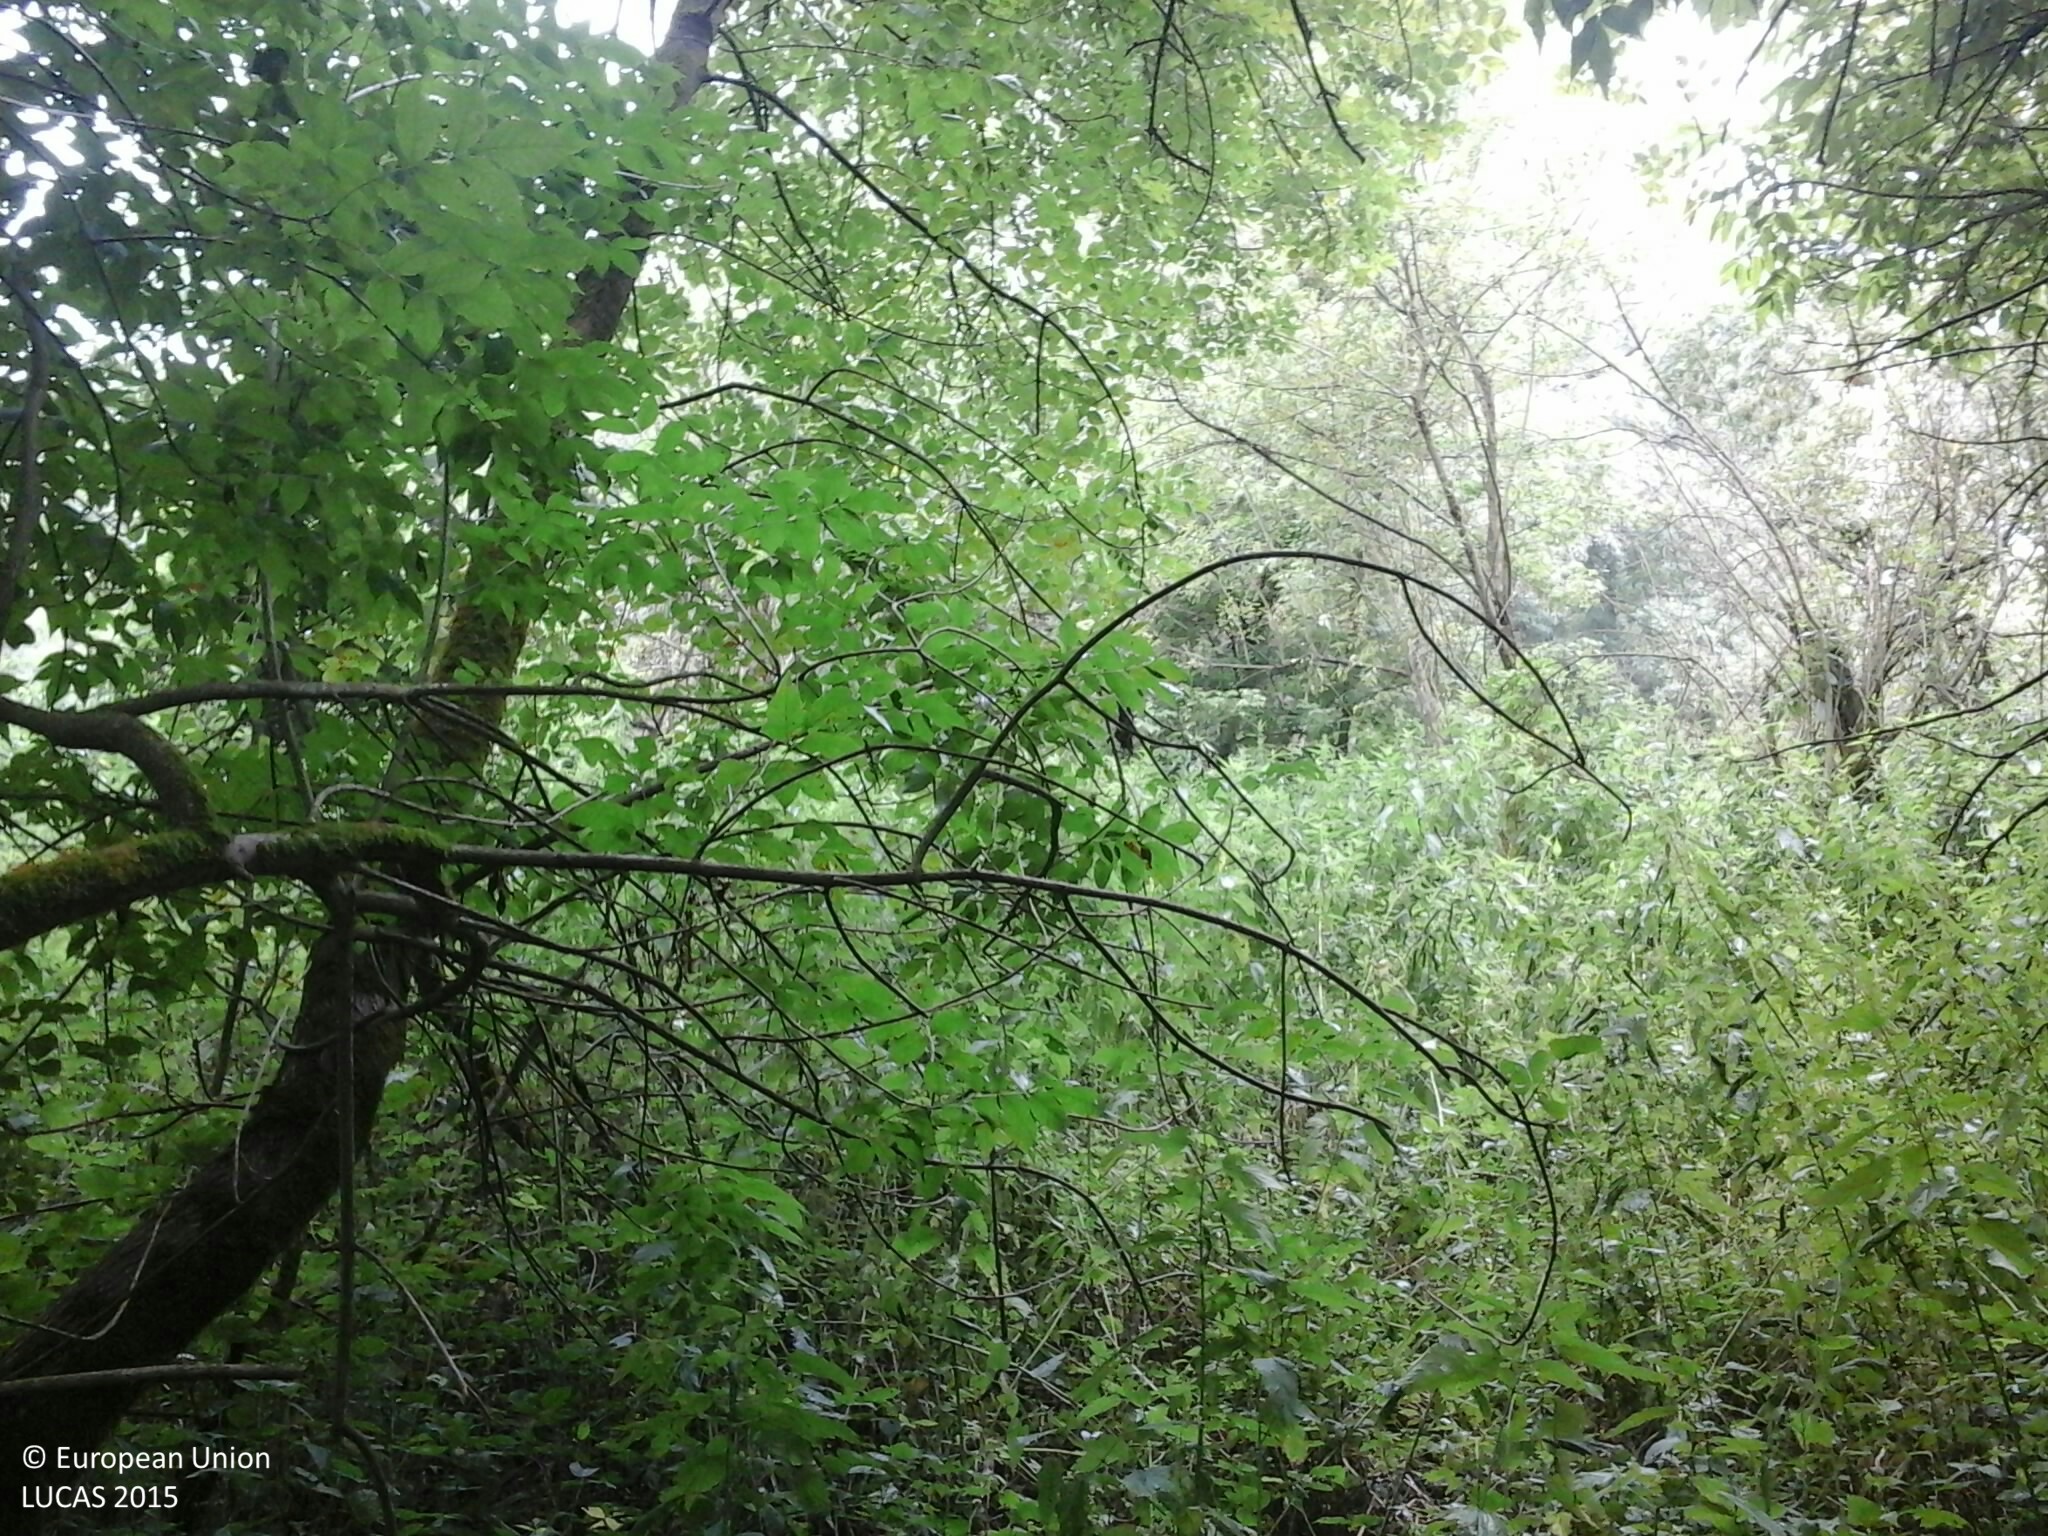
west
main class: Woodland
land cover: Broadleaved woodland
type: mesophytic deciduous forest
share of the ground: > 75 %
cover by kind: broadleaved forest trees 95 %, herbaceous plants 5 %
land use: Forestry
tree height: > 5 m
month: July
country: HU
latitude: 48.3008
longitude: 22.2574
